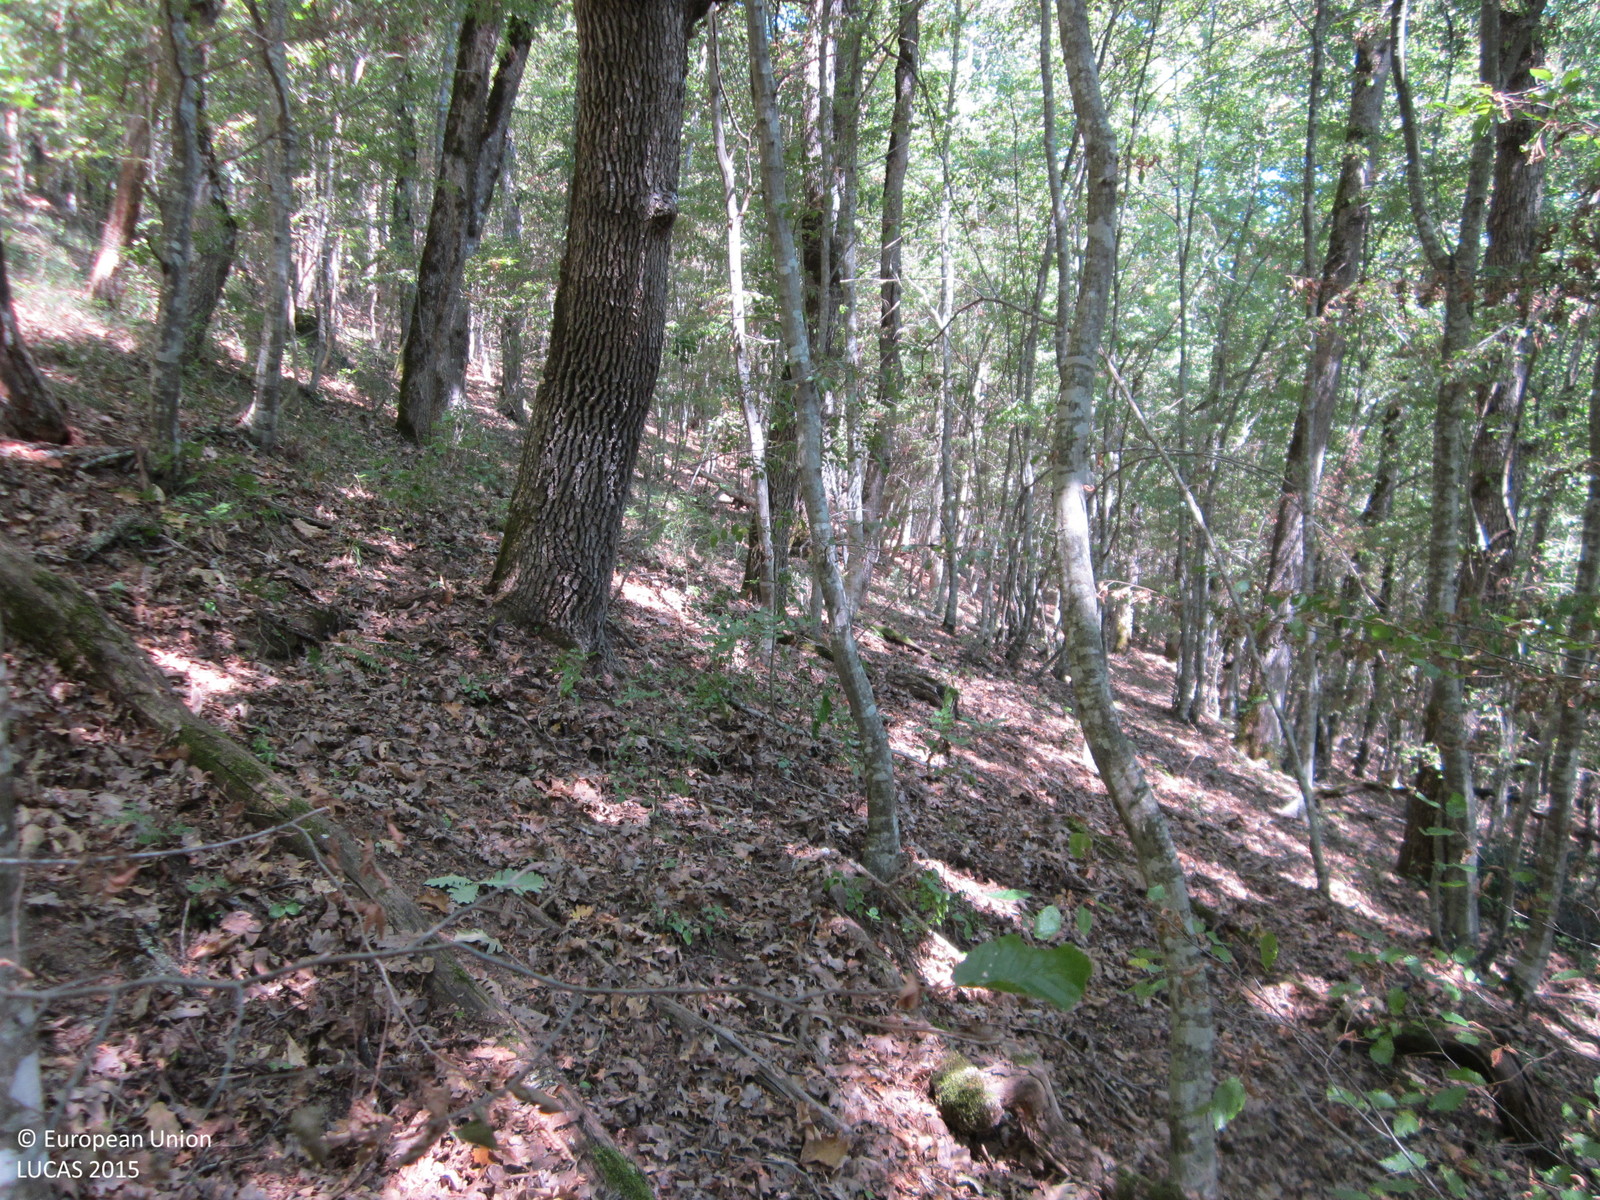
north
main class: Woodland
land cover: Broadleaved woodland
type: thermophilous deciduous forest
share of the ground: > 75 %
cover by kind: broadleaved forest trees 90 %, herbaceous plants 5 %, unconsolidated bare surface 5 %
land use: Forestry
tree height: > 5 m
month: August
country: BG
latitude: 42.0588
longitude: 27.7985
